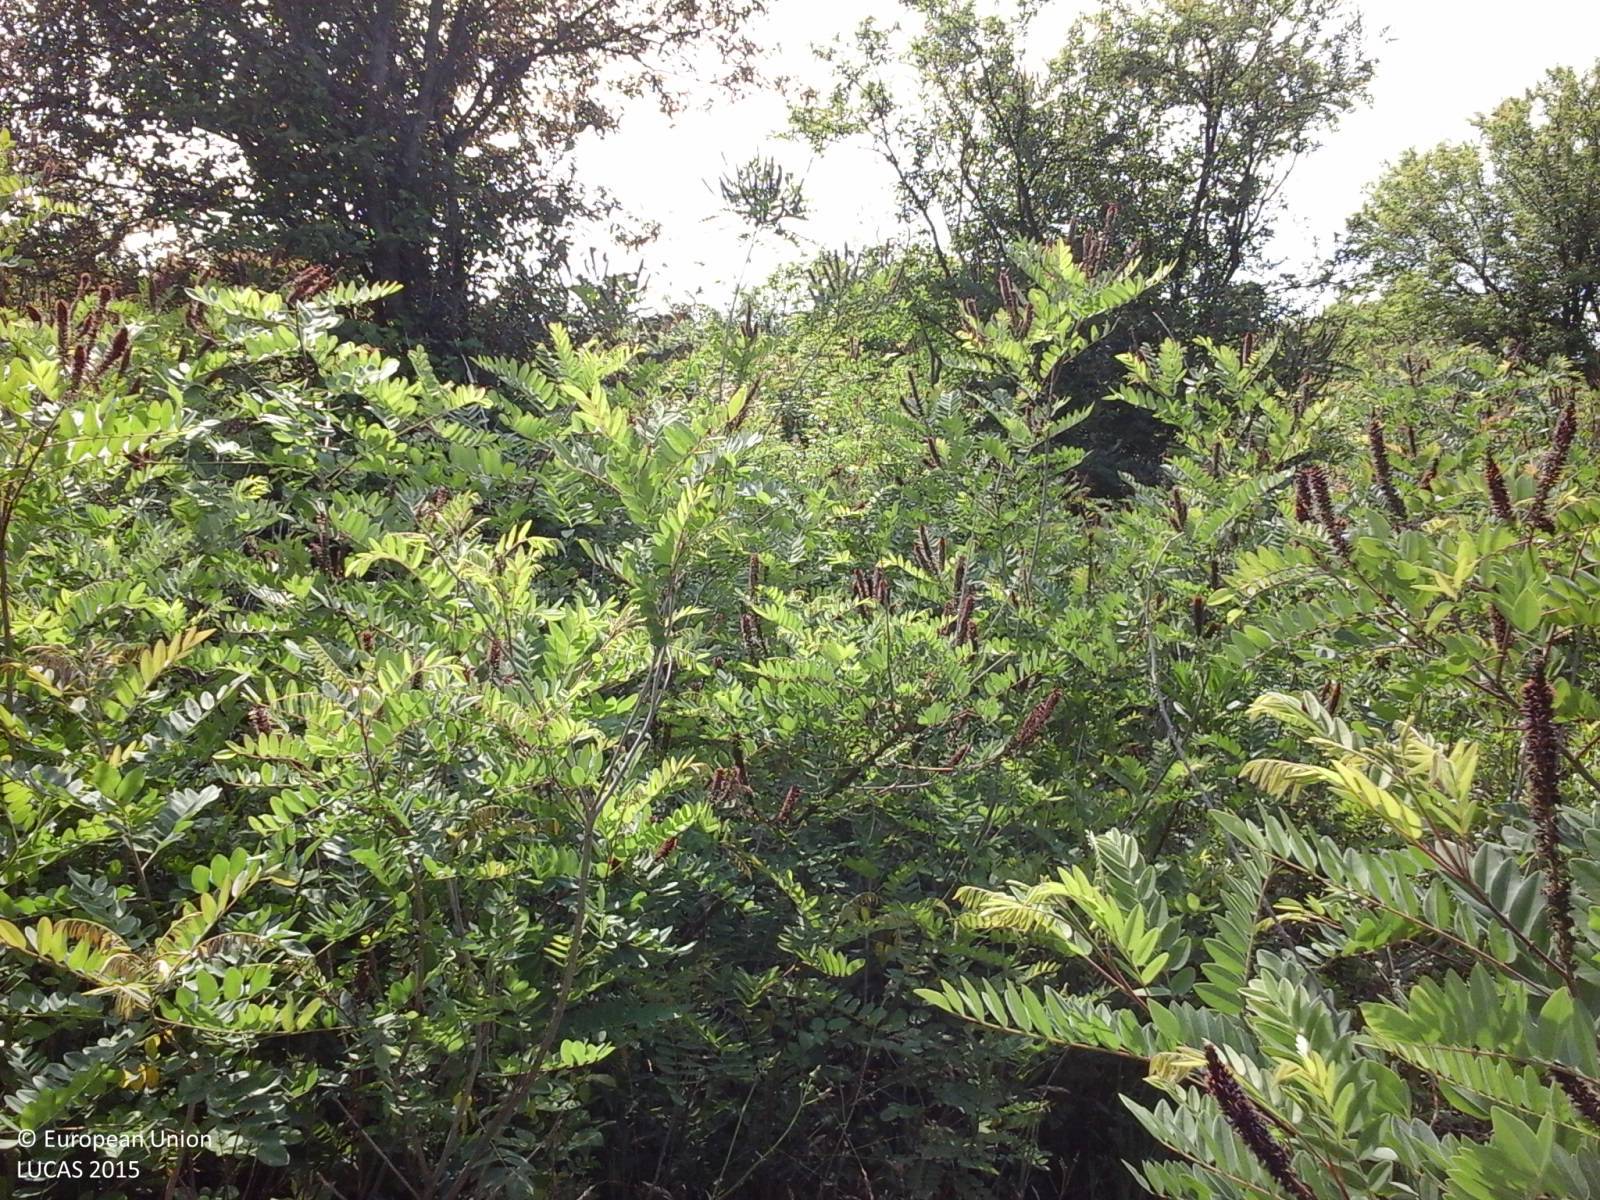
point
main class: Shrubland
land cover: Shrubland with sparse tree cover
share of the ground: > 75 %
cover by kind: shrubs 75 %, herbaceous plants 10 %, unconsolidated bare surface 10 %, broadleaved forest trees 5 %
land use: Semi-natural and natural areas not in use
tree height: > 5 m
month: May
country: IT
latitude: 45.6834
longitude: 13.4239
